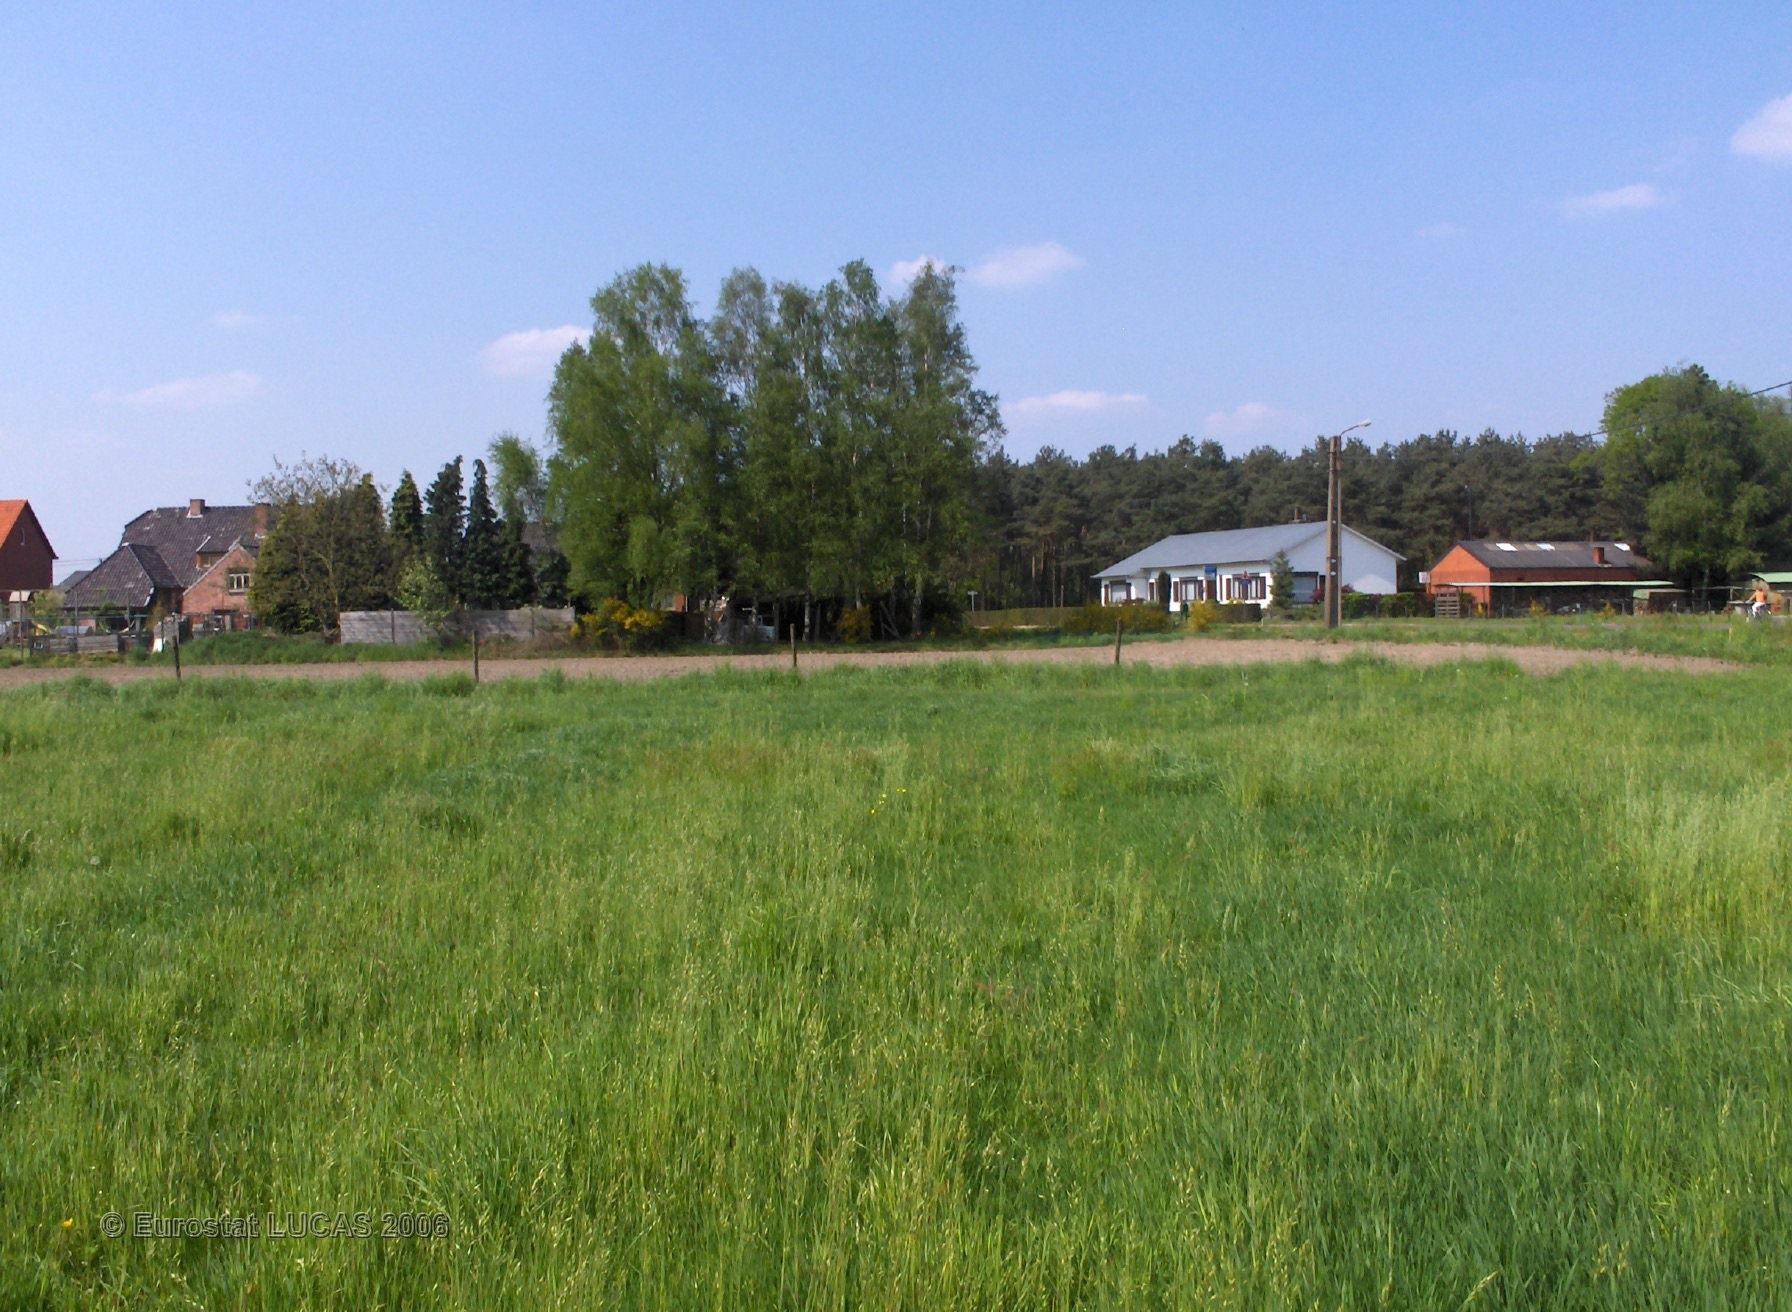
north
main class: Grassland
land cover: Grassland without tree/shrub cover
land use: Agriculture (excluding fallow land and kitchen gardens)
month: May
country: BE
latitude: 51.2515
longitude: 5.1404
